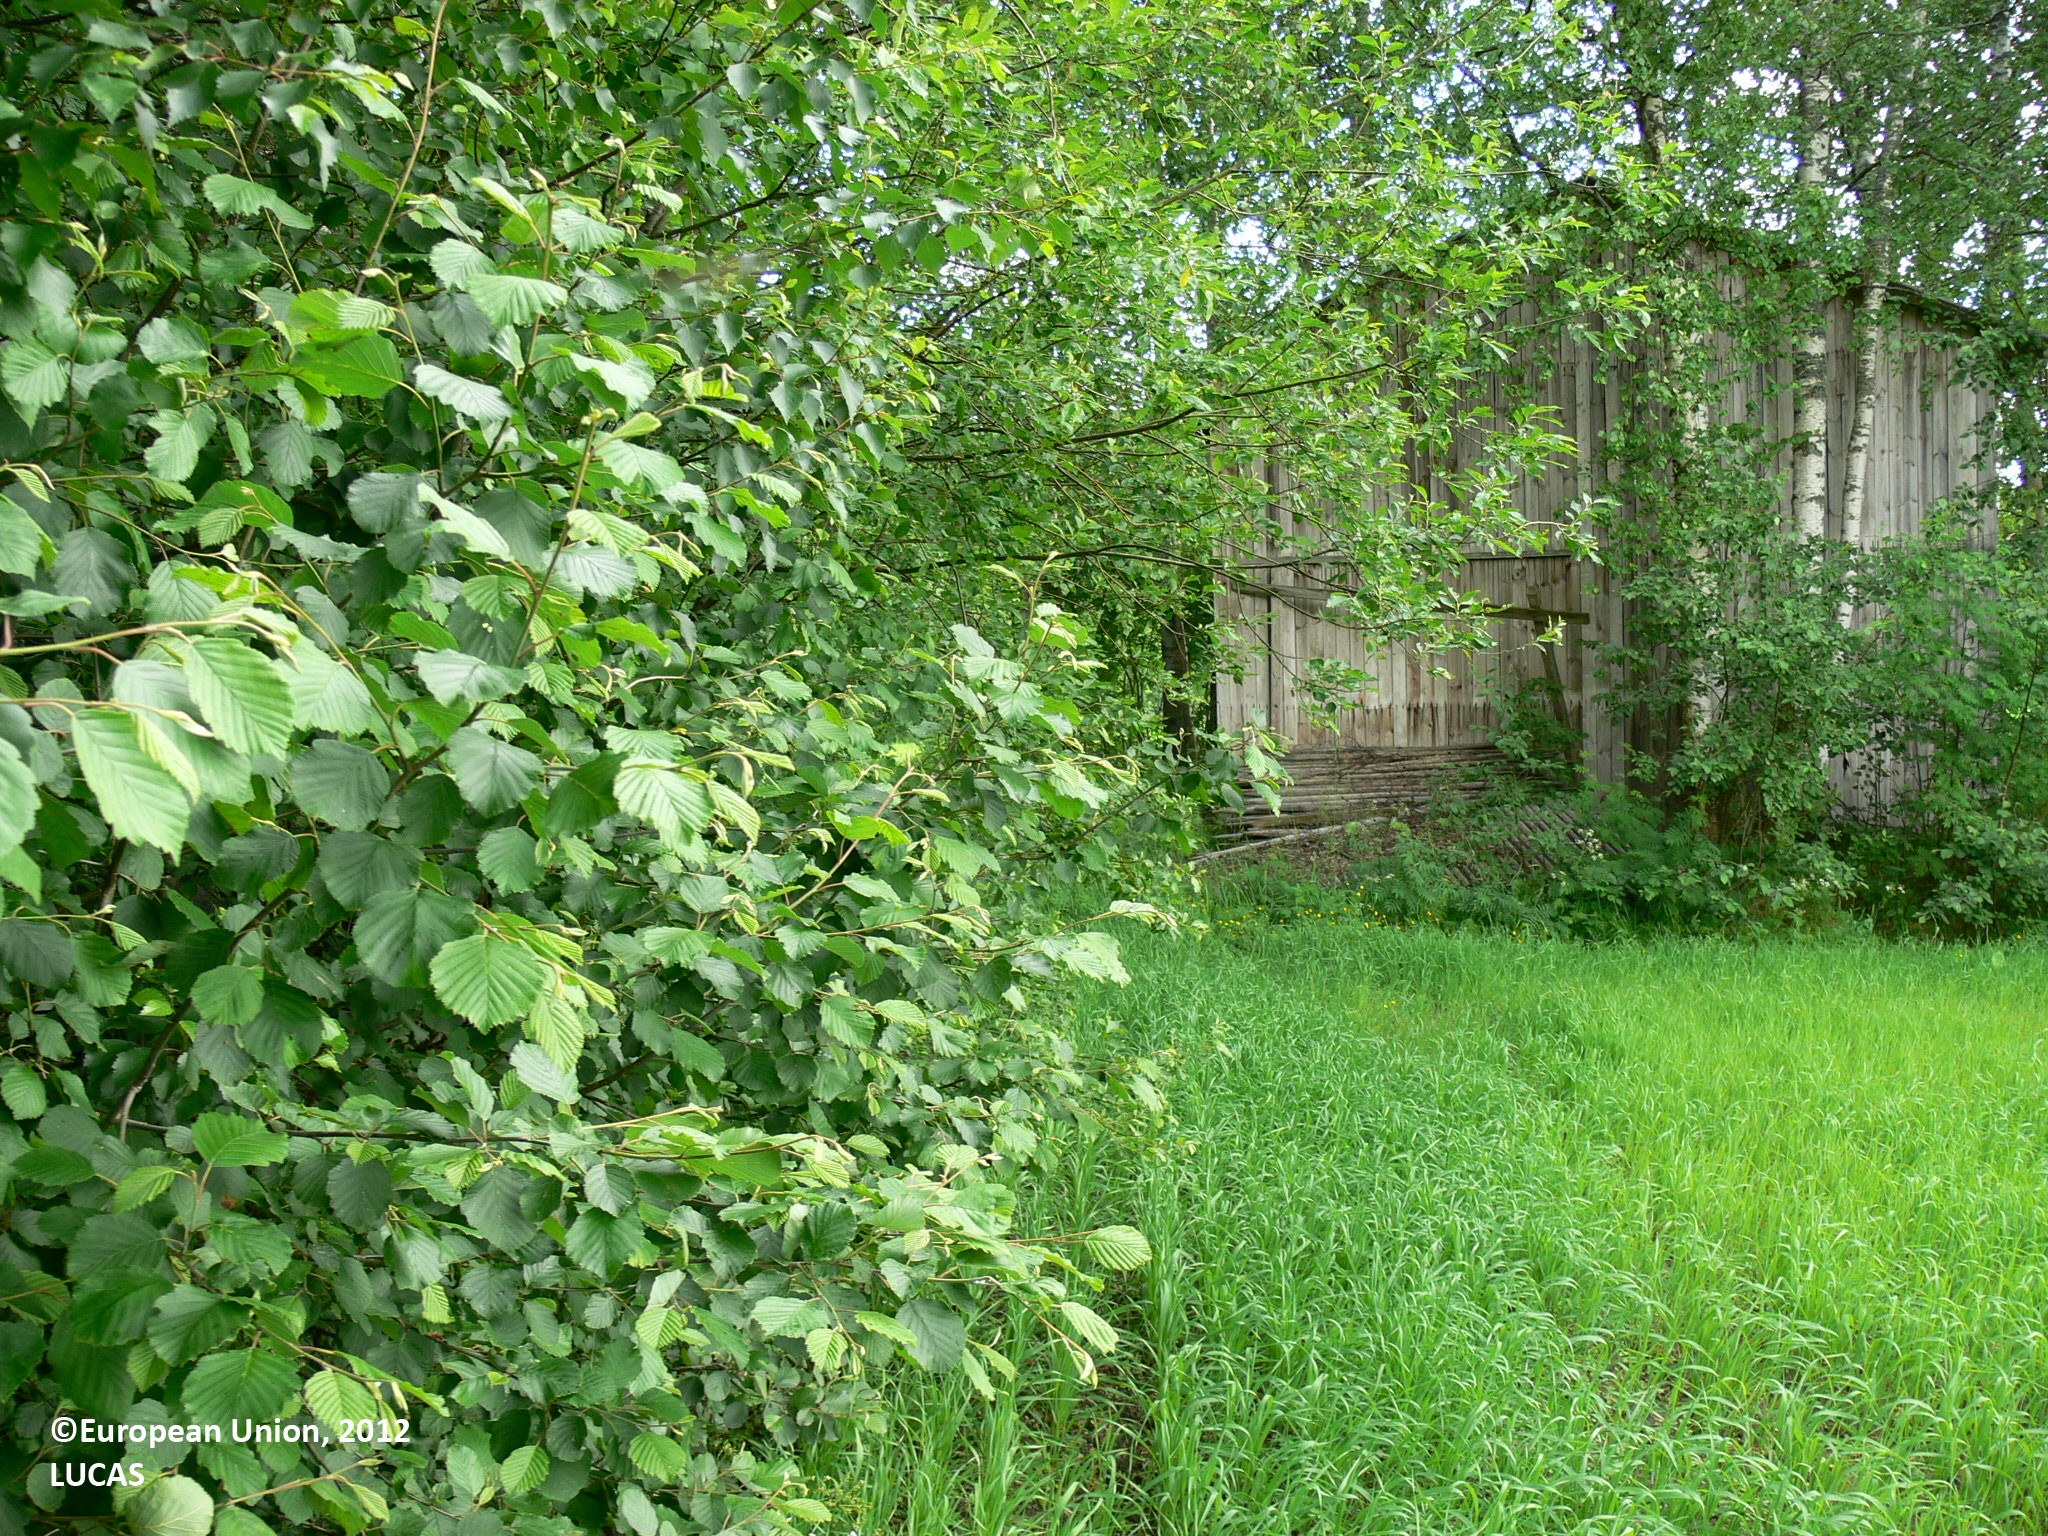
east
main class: Cropland
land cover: Oats
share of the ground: 50 - 75 %
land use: Agriculture (excluding fallow land and kitchen gardens)
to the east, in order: Oats; Grass margins; Ditches and canals; Grass margins; Spruce dominated mixed woodland; Spruce dominated coniferous woodland; Grass margins; Paved roads, cycling and walking lanes; Grass margins; Ditches and canals; Grass margins; Pine dominated coniferous woodland; Spruce dominated coniferous woodland
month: June
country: FI
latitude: 62.4255
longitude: 29.5890
